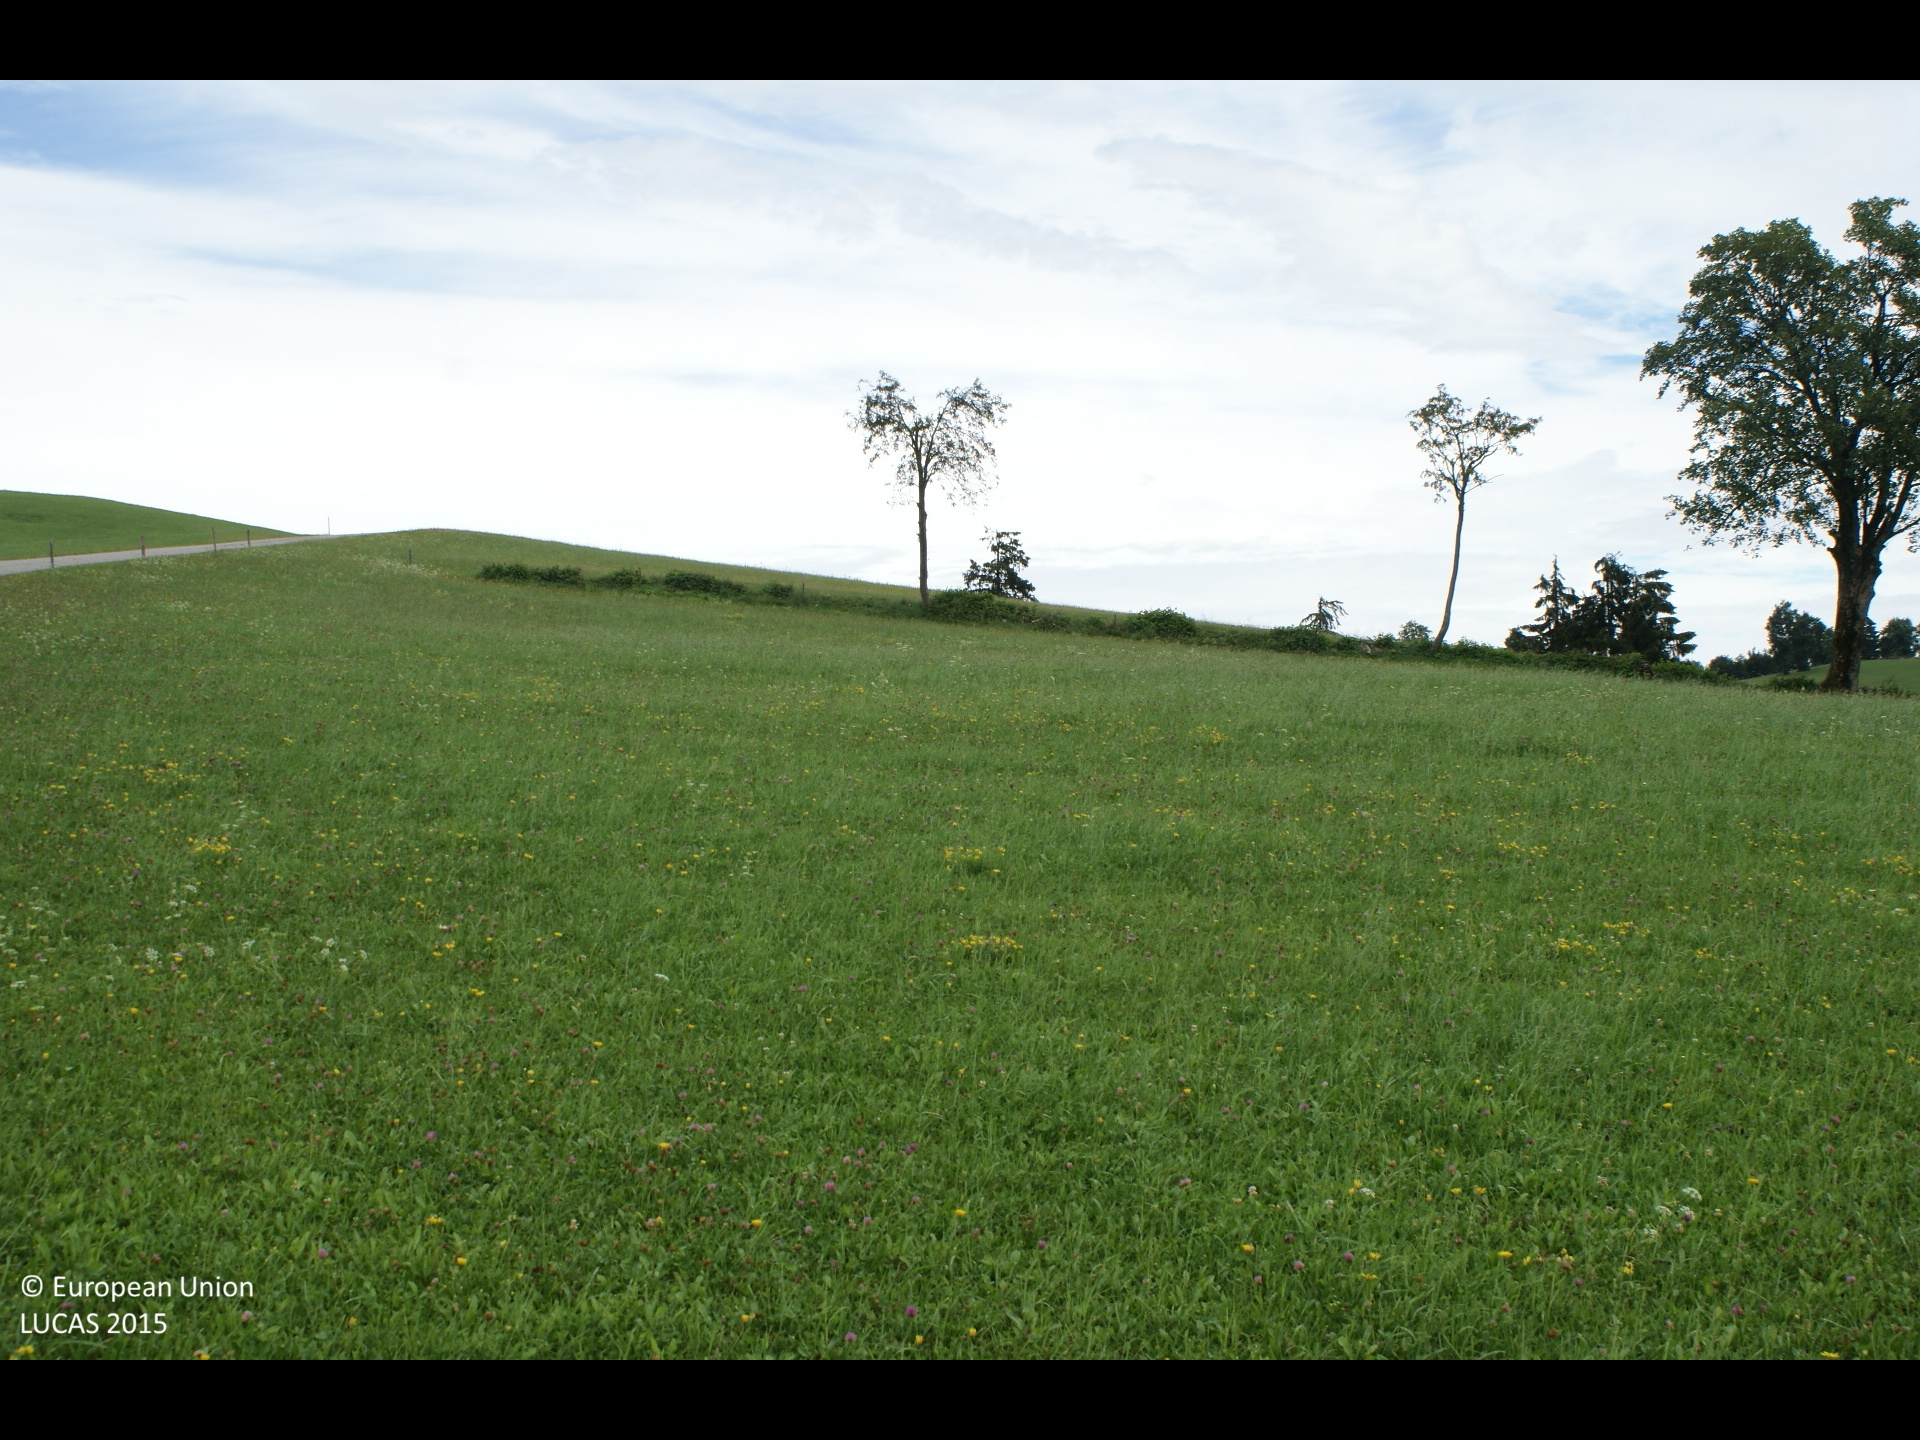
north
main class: Grassland
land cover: Grassland without tree/shrub cover
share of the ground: > 75 %
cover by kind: herbaceous plants 100 %
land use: Agriculture (excluding fallow land and kitchen gardens)
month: July
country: AT
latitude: 47.9852
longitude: 14.9717
